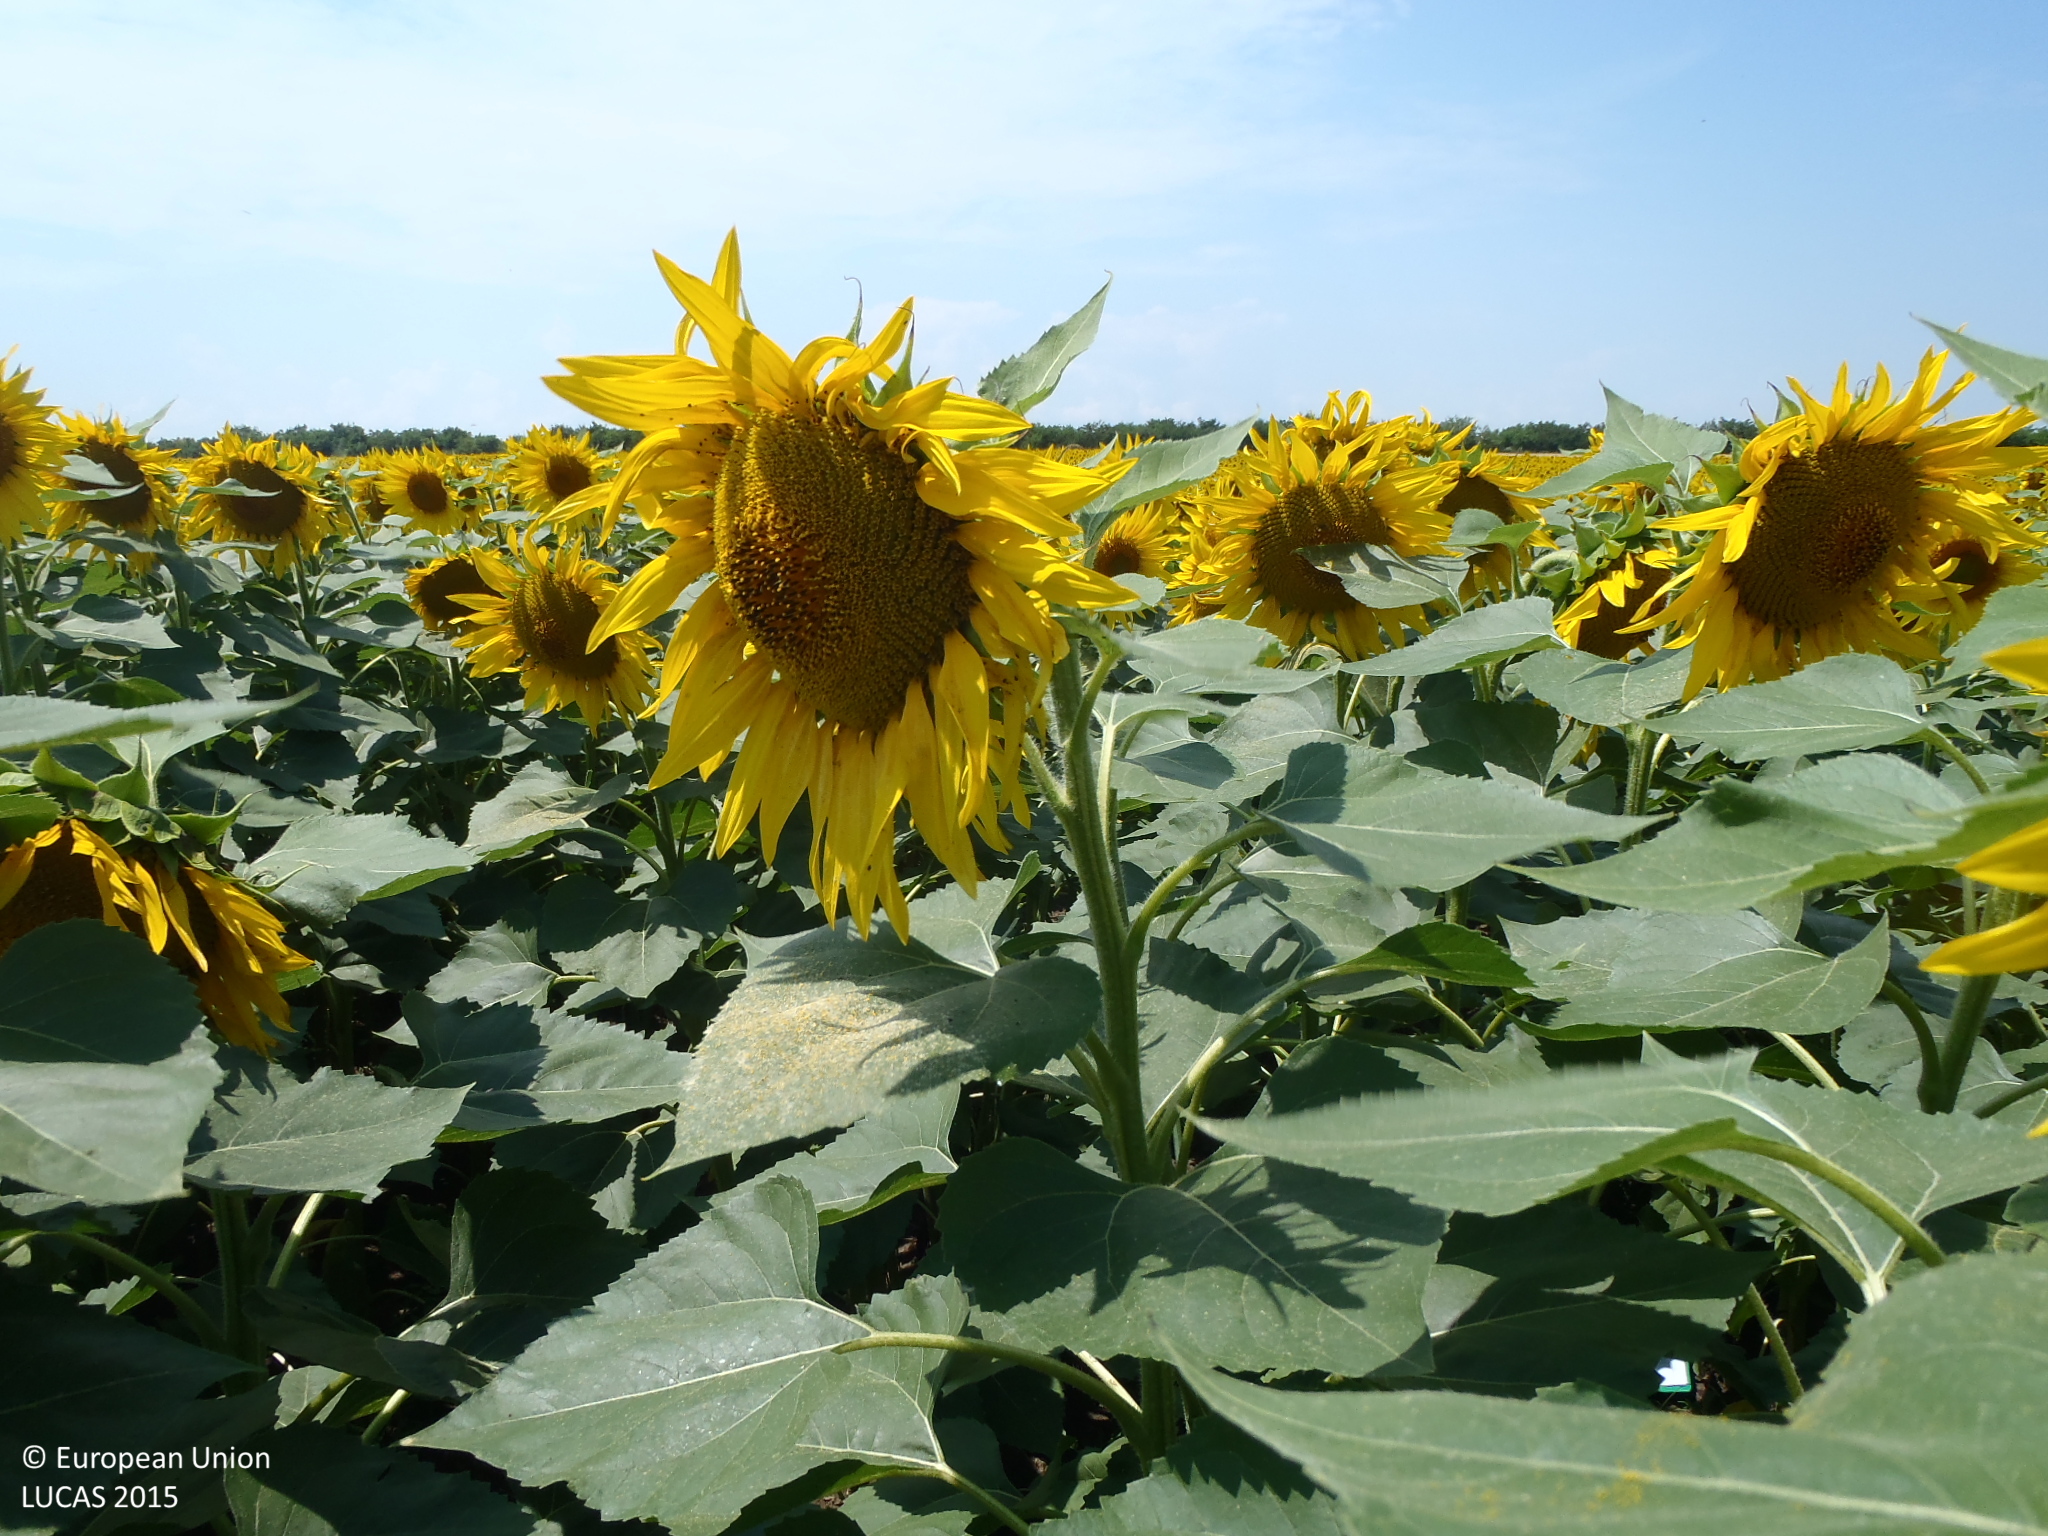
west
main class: Cropland
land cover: Sunflower
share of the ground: > 75 %
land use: Agriculture (excluding fallow land and kitchen gardens)
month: July
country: BG
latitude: 43.9450
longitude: 26.3403
